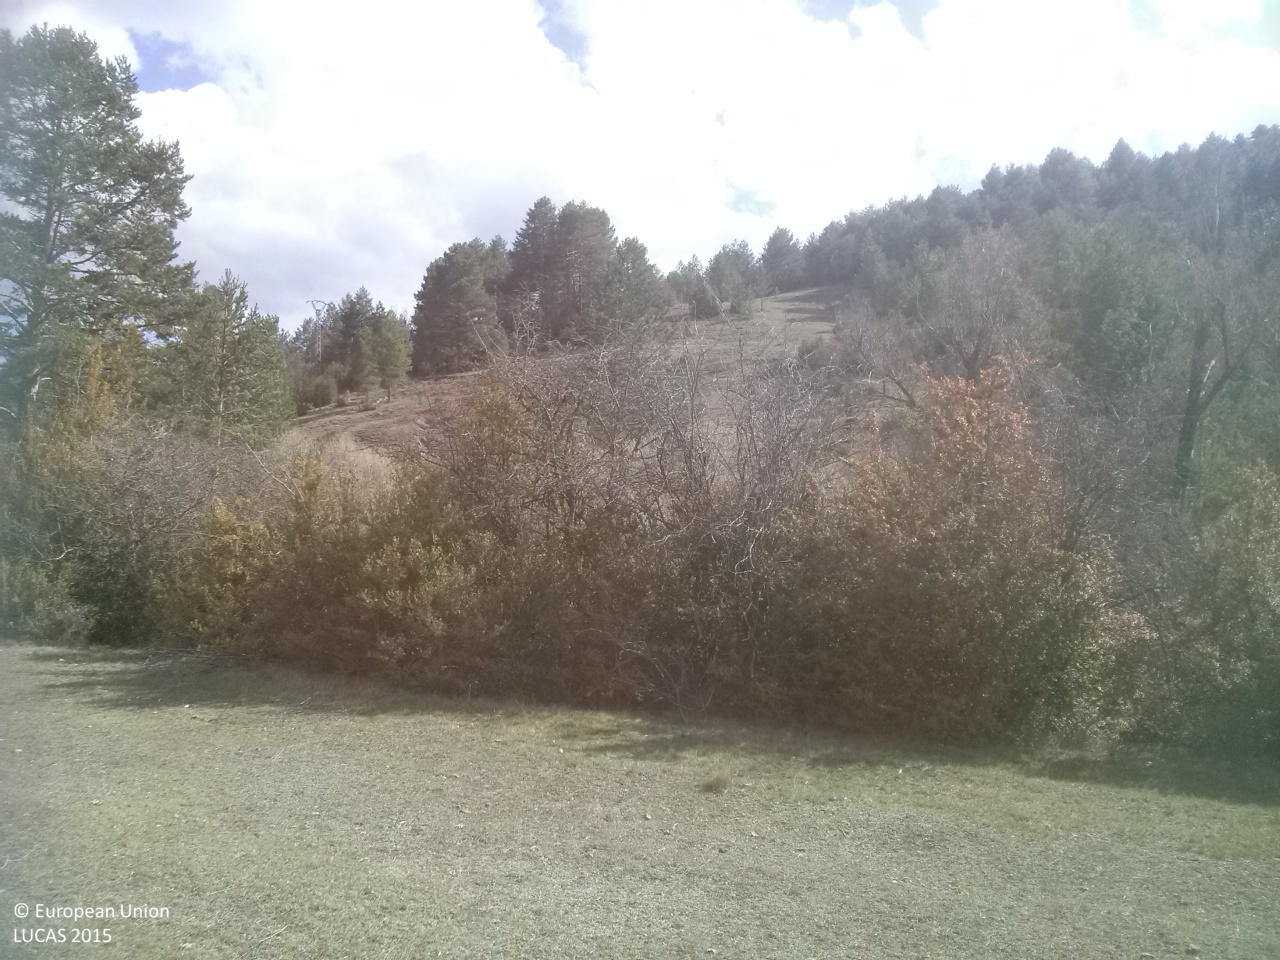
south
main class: Woodland
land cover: Pine dominated coniferous woodland
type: coniferous forest of the mediterranean region
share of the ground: > 75 %
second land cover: Grassland without tree/shrub cover
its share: 10 - 25 %
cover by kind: coniferous forest trees 80 %, shrubs 10 %, herbaceous plants 10 %
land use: Forestry
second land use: Agriculture (excluding fallow land and kitchen gardens)
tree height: > 5 m
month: April
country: ES
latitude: 40.2844
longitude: -1.7892
